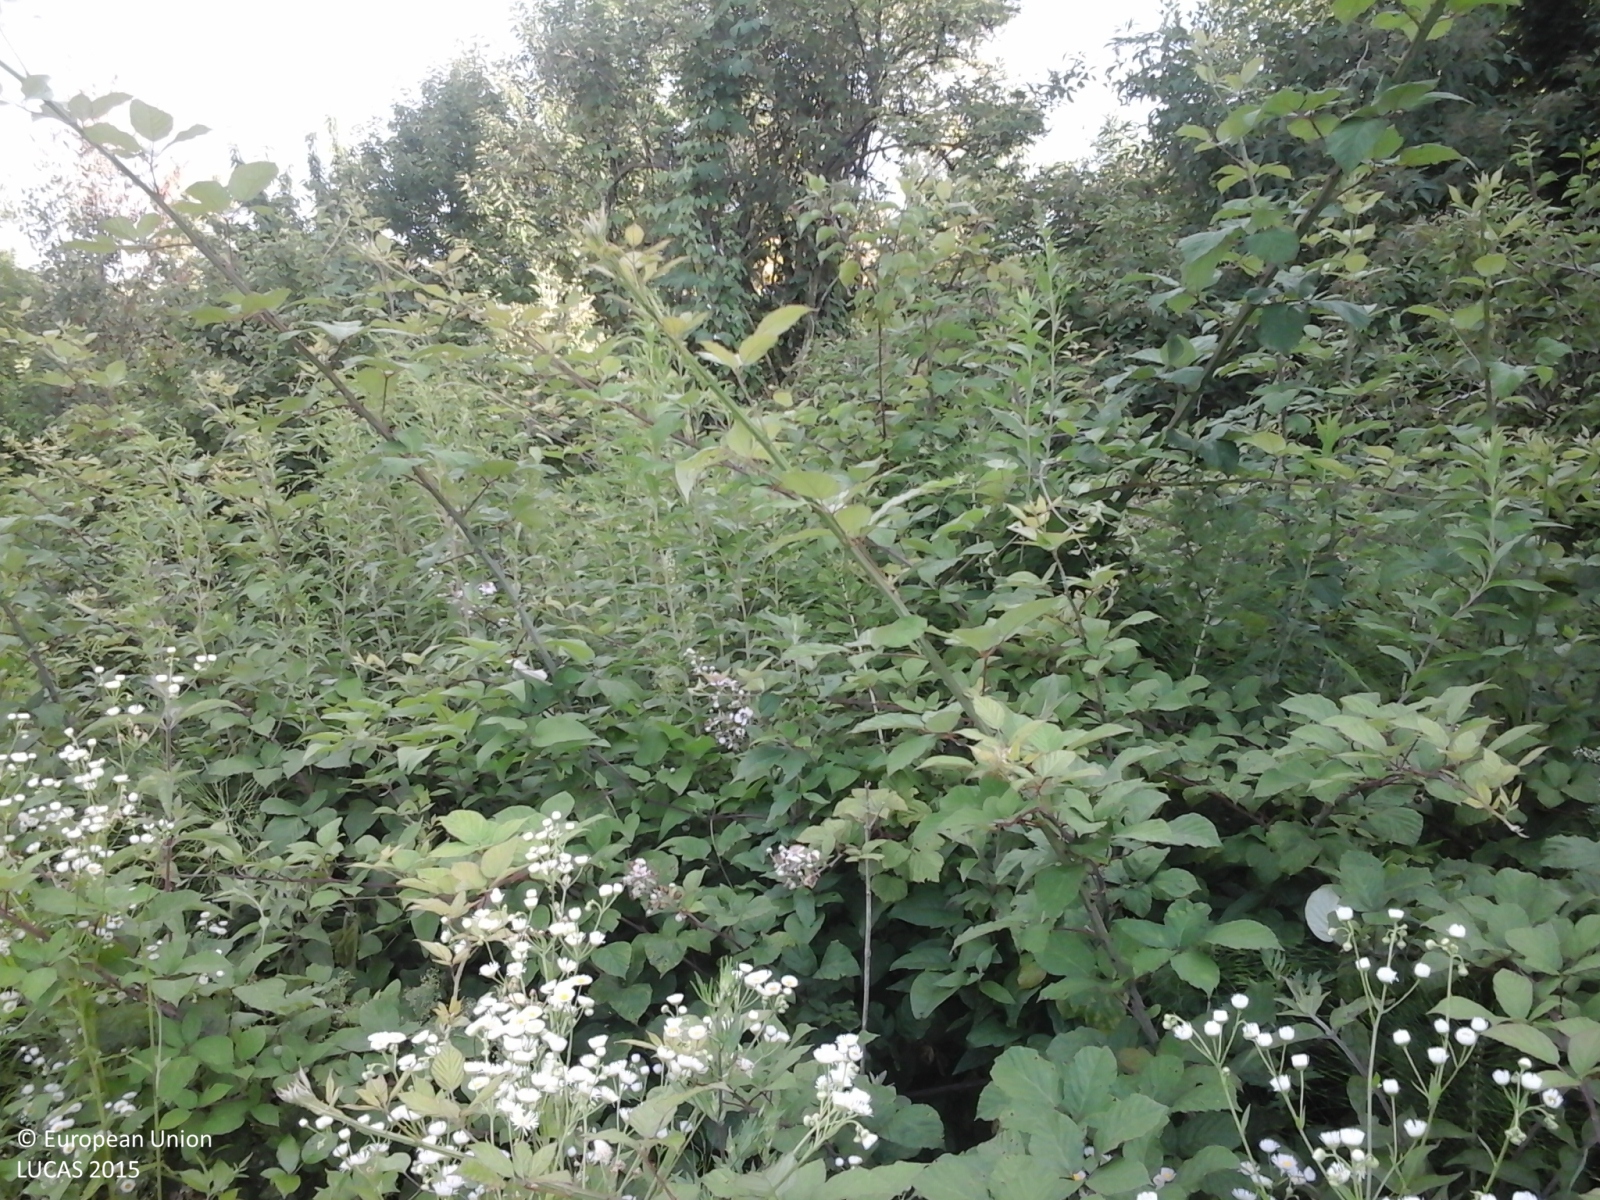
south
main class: Woodland
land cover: Broadleaved woodland
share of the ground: > 75 %
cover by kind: broadleaved forest trees 75 %, shrubs 25 %
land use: Semi-natural and natural areas not in use
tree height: > 5 m
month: June
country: IT
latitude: 45.0955
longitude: 8.3892
